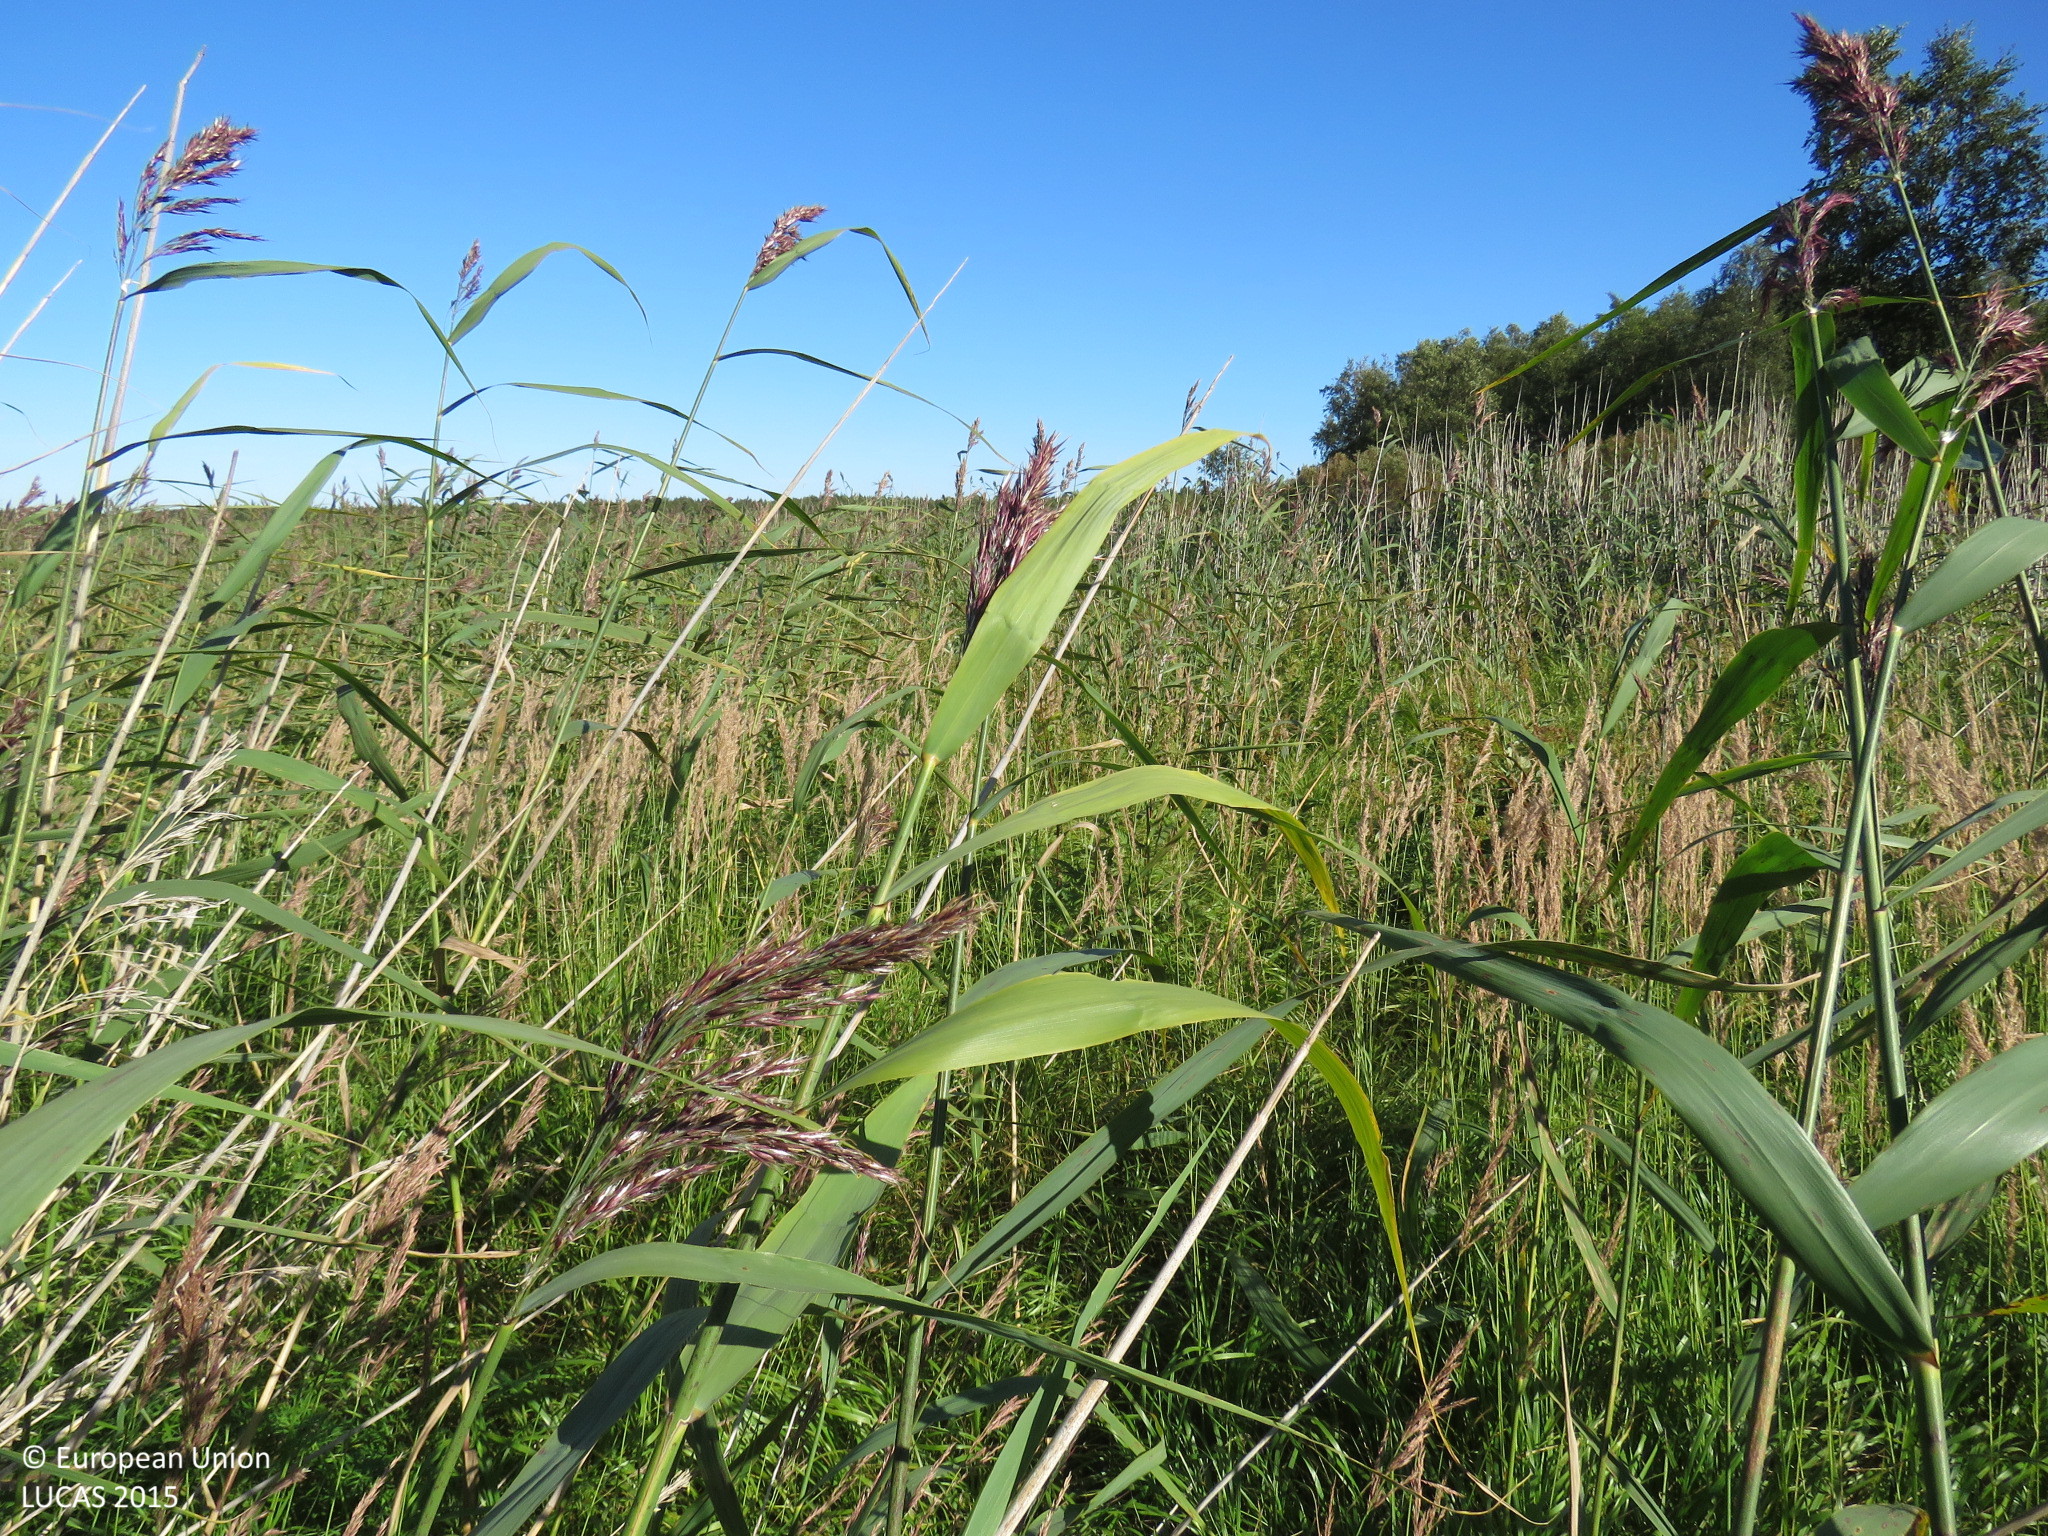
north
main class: Grassland
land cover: Grassland without tree/shrub cover
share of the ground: > 75 %
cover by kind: herbaceous plants 95 %, shrubs 5 %
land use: Semi-natural and natural areas not in use
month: August
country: FI
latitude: 64.9766
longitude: 24.7518
